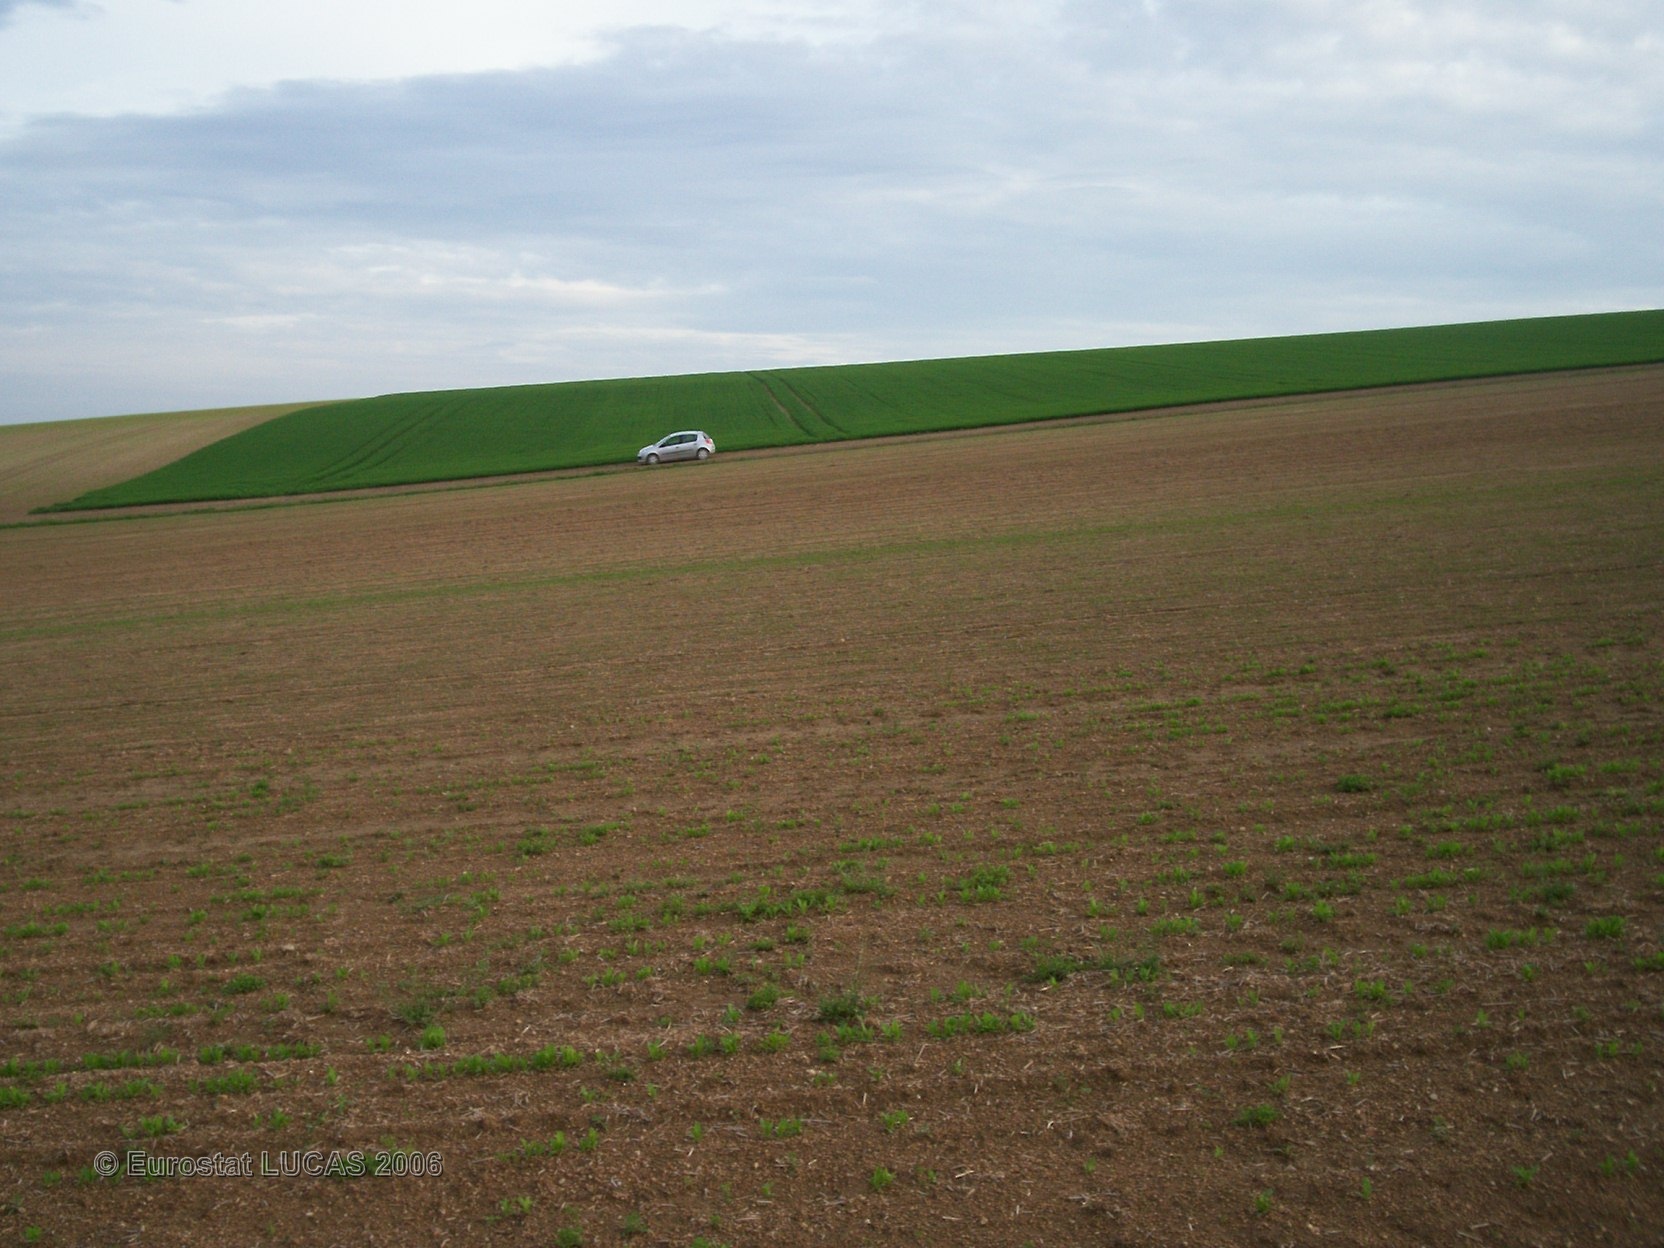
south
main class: Cropland
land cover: Other fibre and oleaginous crops
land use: Agriculture (excluding fallow land and kitchen gardens)
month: May
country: FR
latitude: 49.2150
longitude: 4.3538
